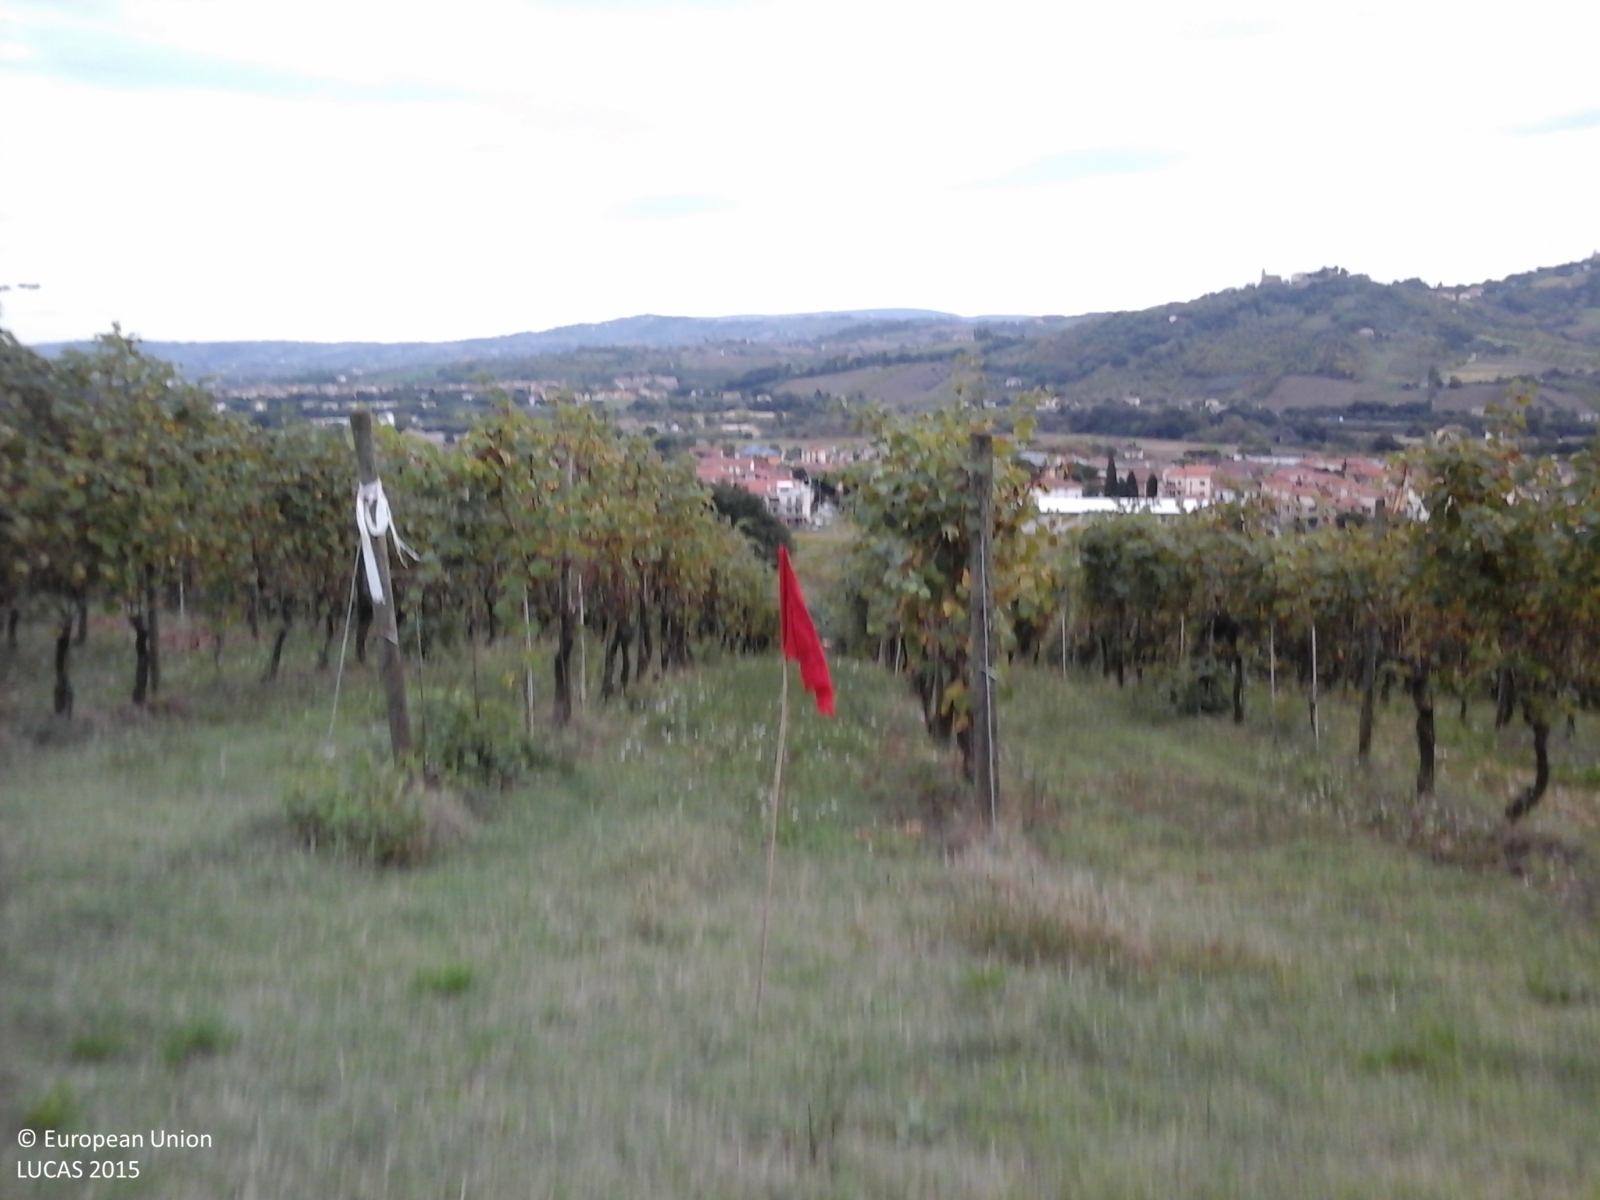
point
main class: Grassland
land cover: Grassland without tree/shrub cover
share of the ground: 25 - 50 %
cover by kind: herbaceous plants 100 %
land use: Agriculture (excluding fallow land and kitchen gardens)
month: October
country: IT
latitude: 43.5085
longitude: 13.1463
